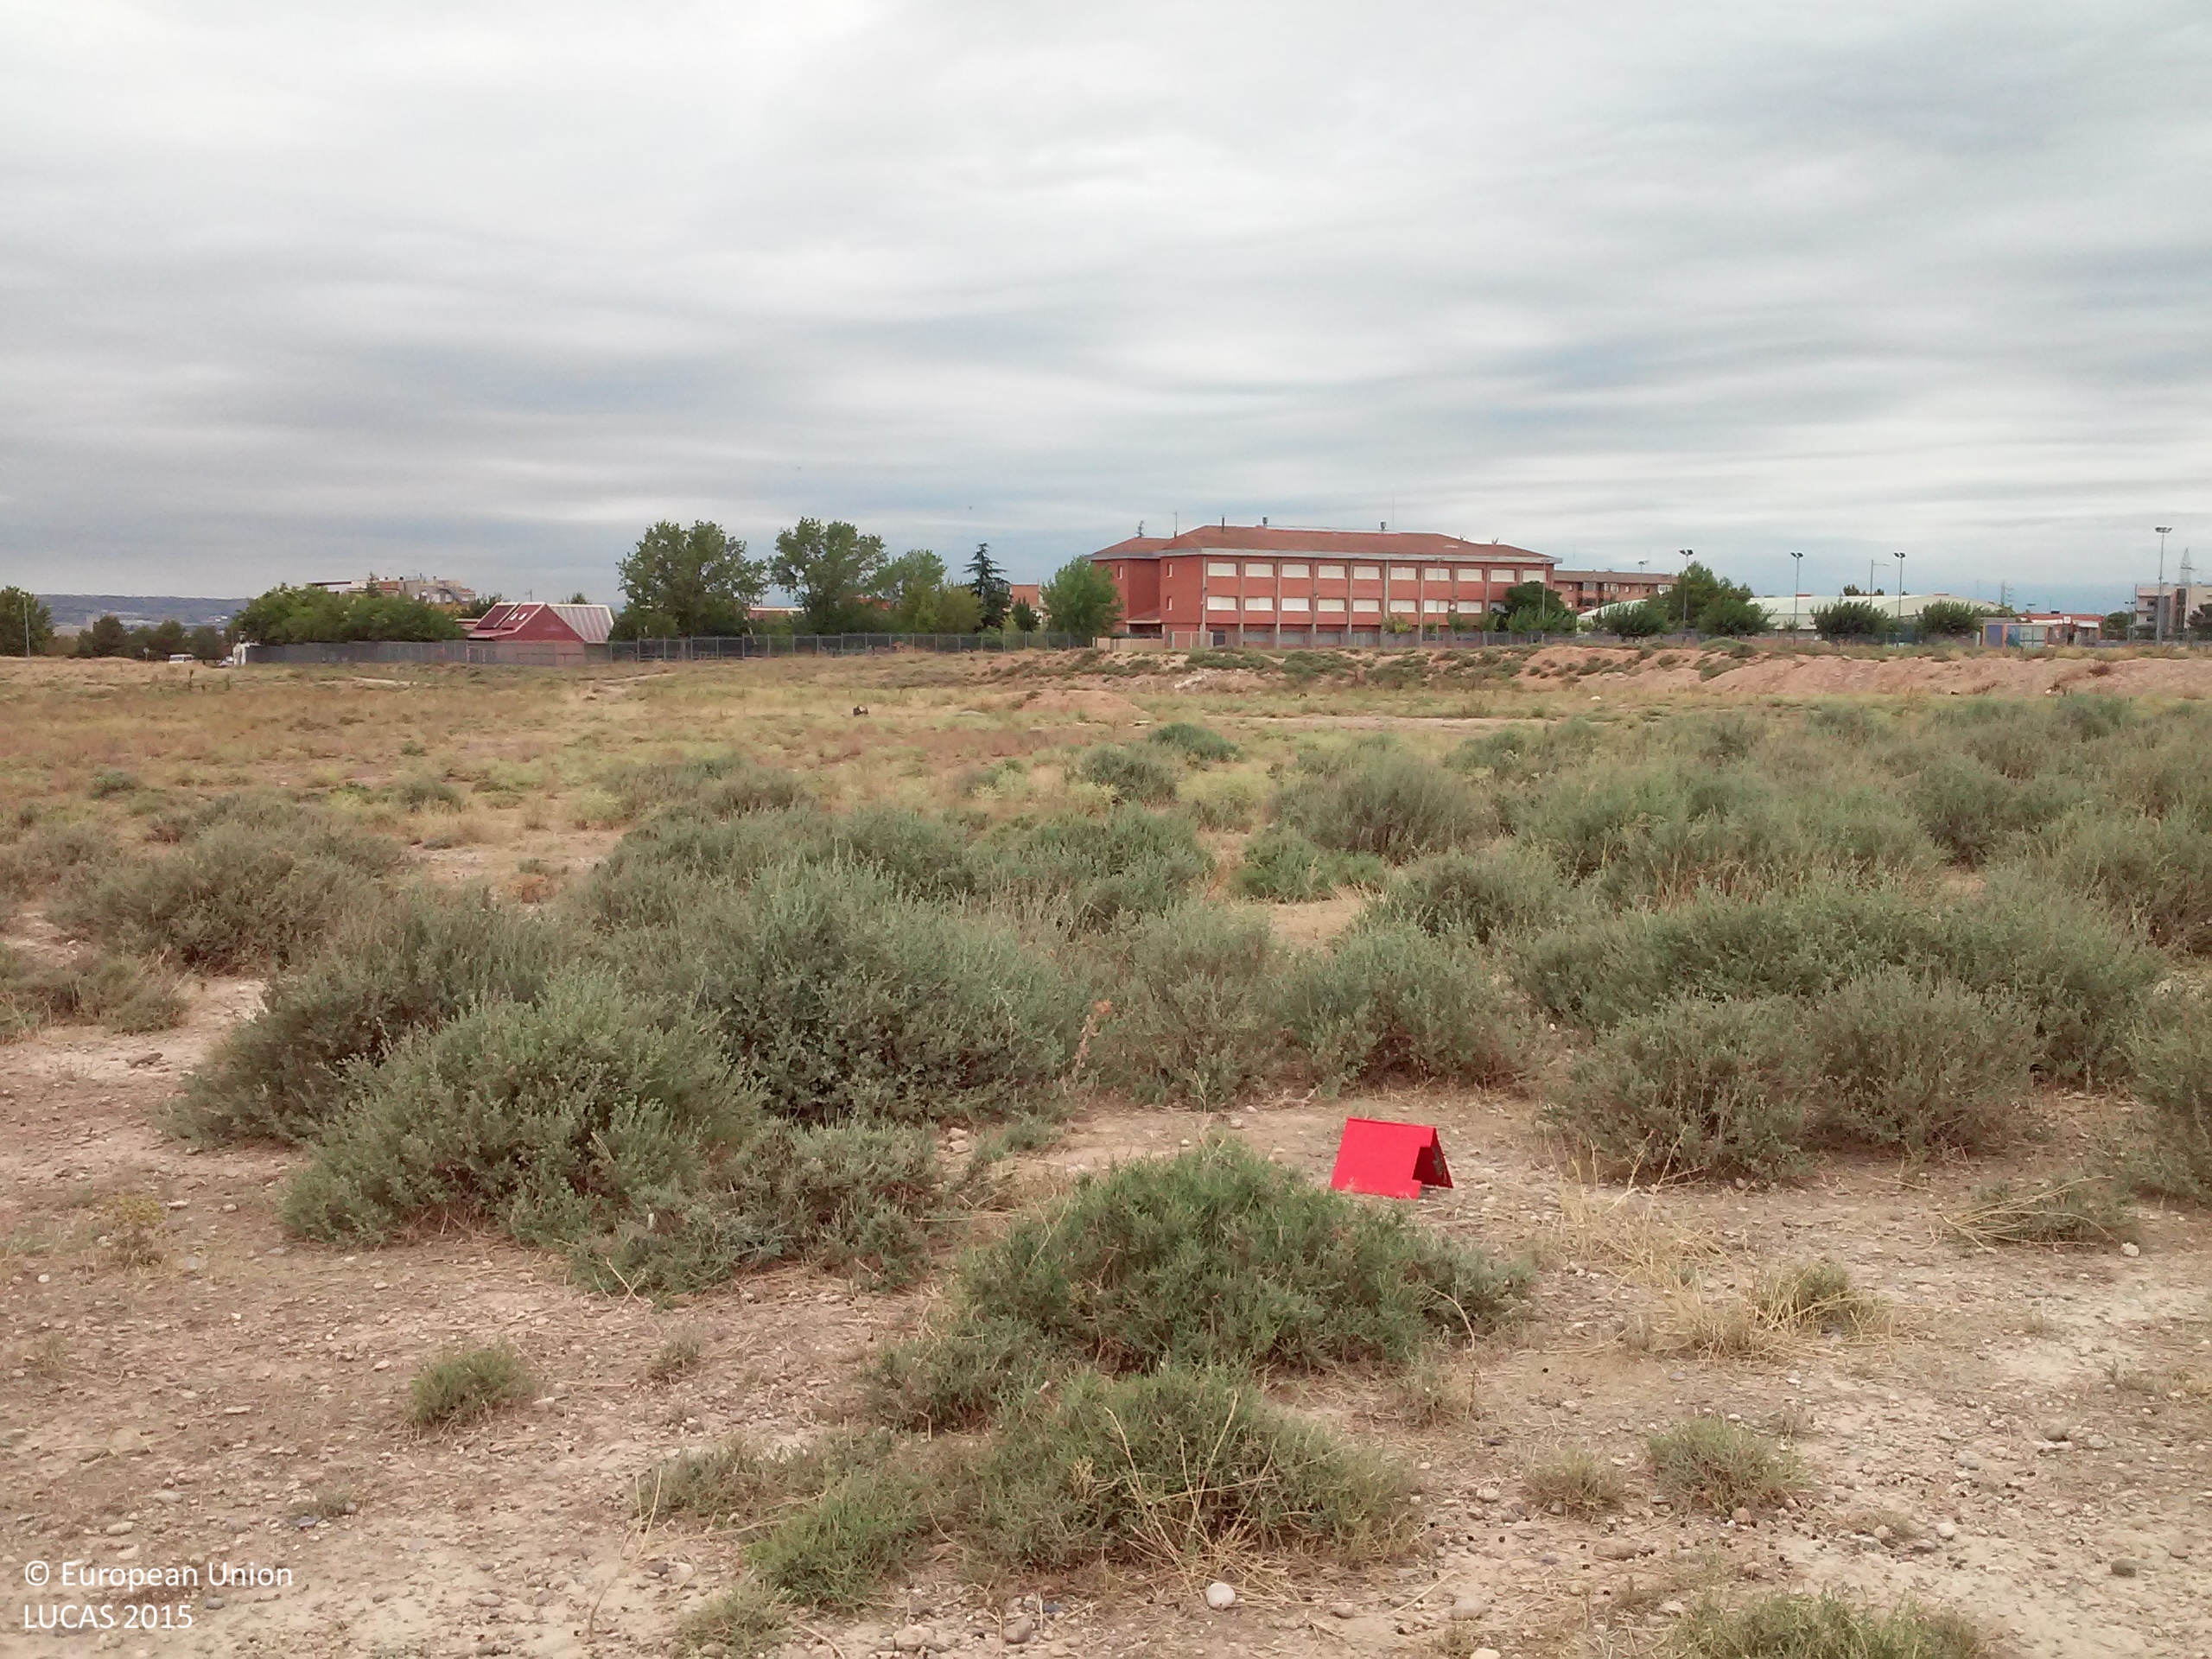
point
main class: Grassland
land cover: Grassland without tree/shrub cover
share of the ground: > 75 %
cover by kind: herbaceous plants 60 %, consolidated bare surface 35 %, shrubs 5 %
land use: Residential
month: July
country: ES
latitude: 41.6041
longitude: 0.6650
